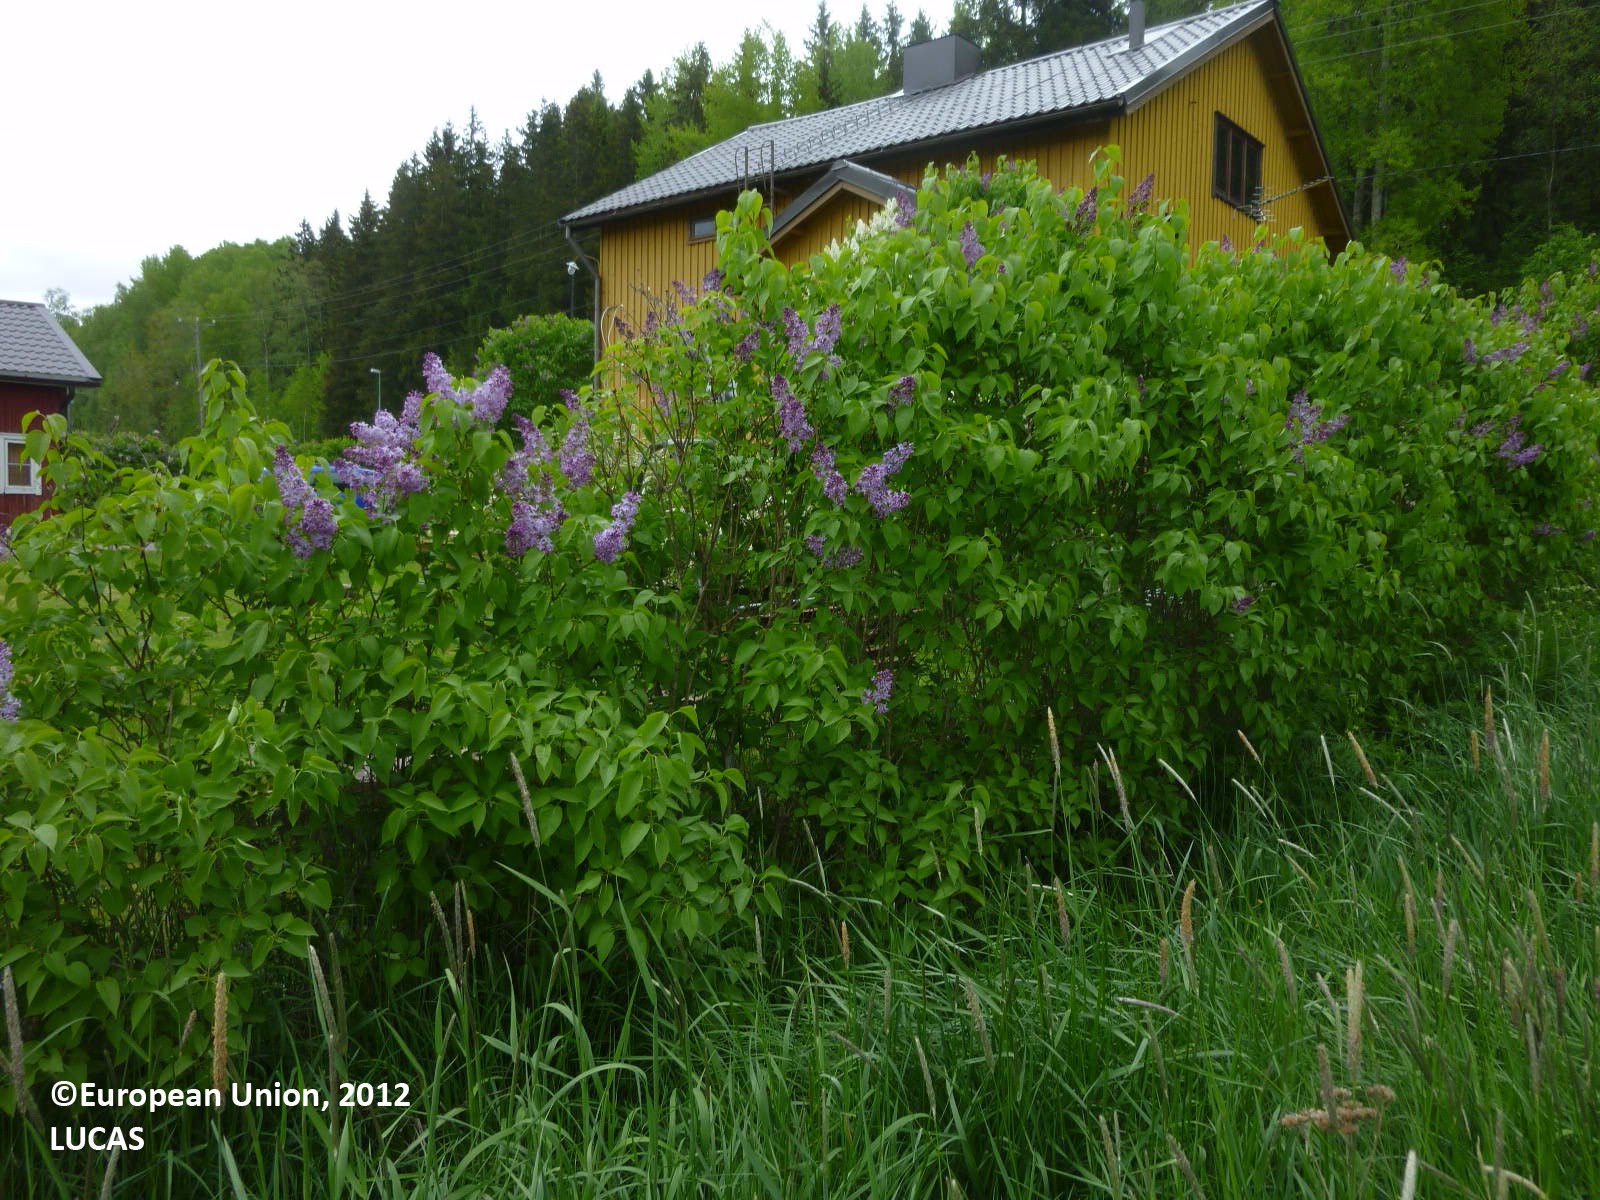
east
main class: Cropland
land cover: Temporary grasslands
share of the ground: > 75 %
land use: Agriculture (excluding fallow land and kitchen gardens)
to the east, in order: Temporary grasslands; Managed hedges; Grassland without tree/shrub cover; Grass margins; Electric lines; Paved roads, cycling and walking lanes; Grass margins; Spruce dominated mixed woodland
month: June
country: FI
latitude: 60.4614
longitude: 22.7115
